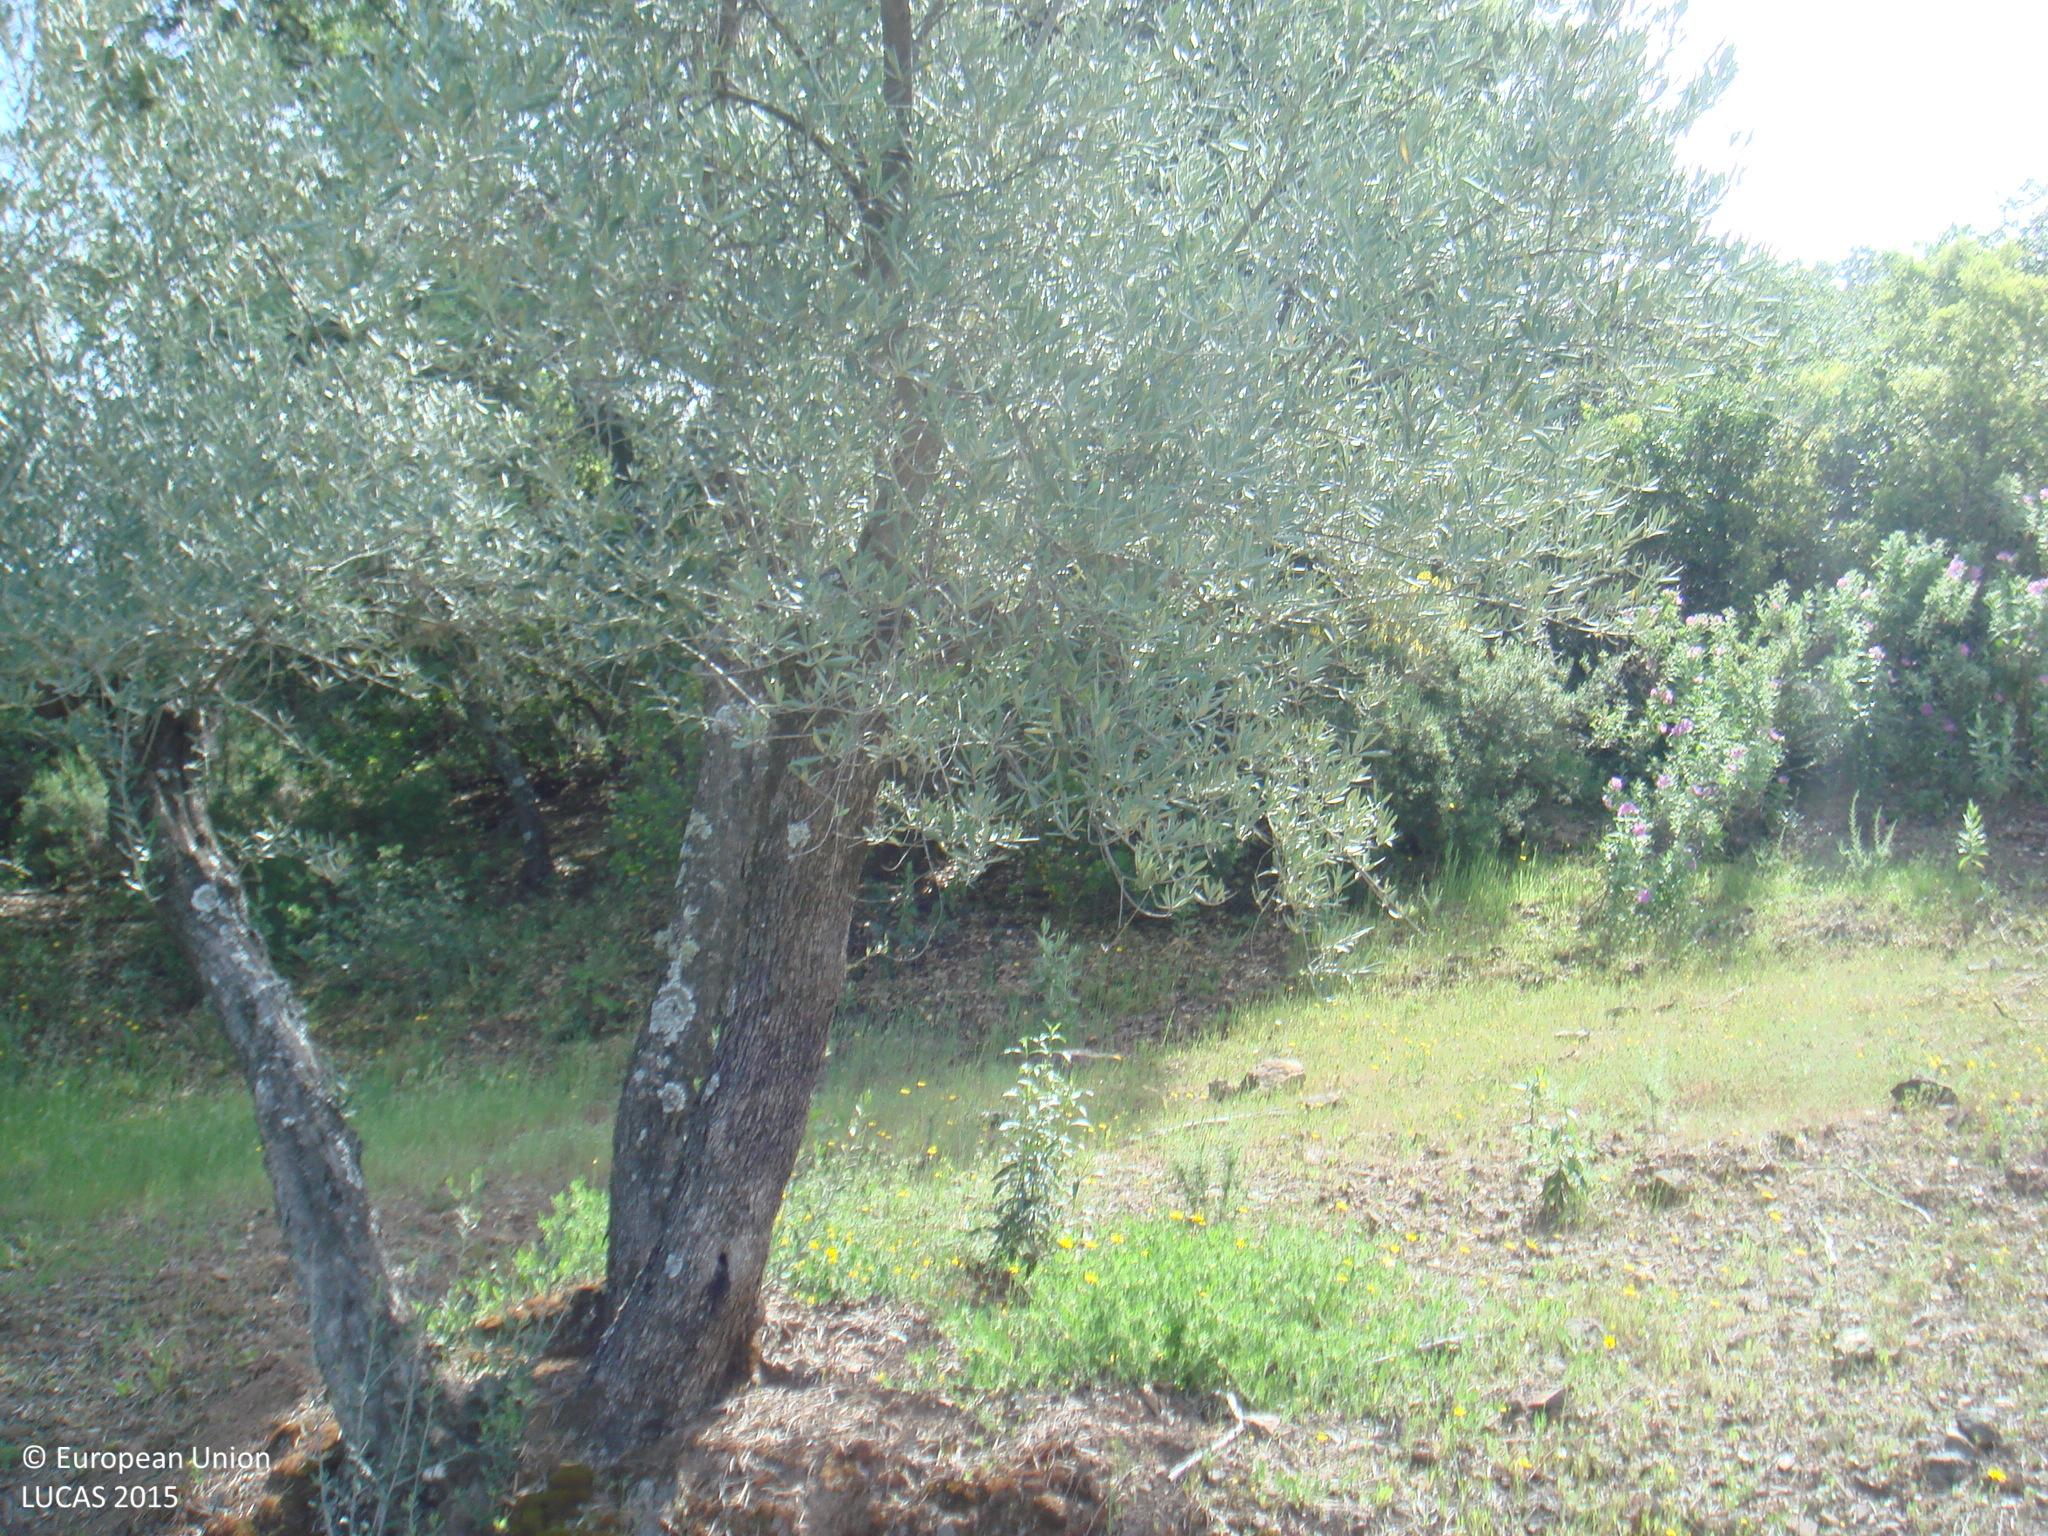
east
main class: Cropland
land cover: Olive groves
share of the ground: 25 - 50 %
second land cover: Spontaneously vegetated surfaces
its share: > 75 %
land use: Agriculture (excluding fallow land and kitchen gardens)
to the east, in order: Olive groves; Spontaneously vegetated surfaces; Shrubland with sparse tree cover; Fences; Shrubland with sparse tree cover; Paved roads, cycling and walking lanes; Broadleaved woodland; Fences; Broadleaved woodland
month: April
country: ES
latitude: 38.1604
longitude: -4.7064
